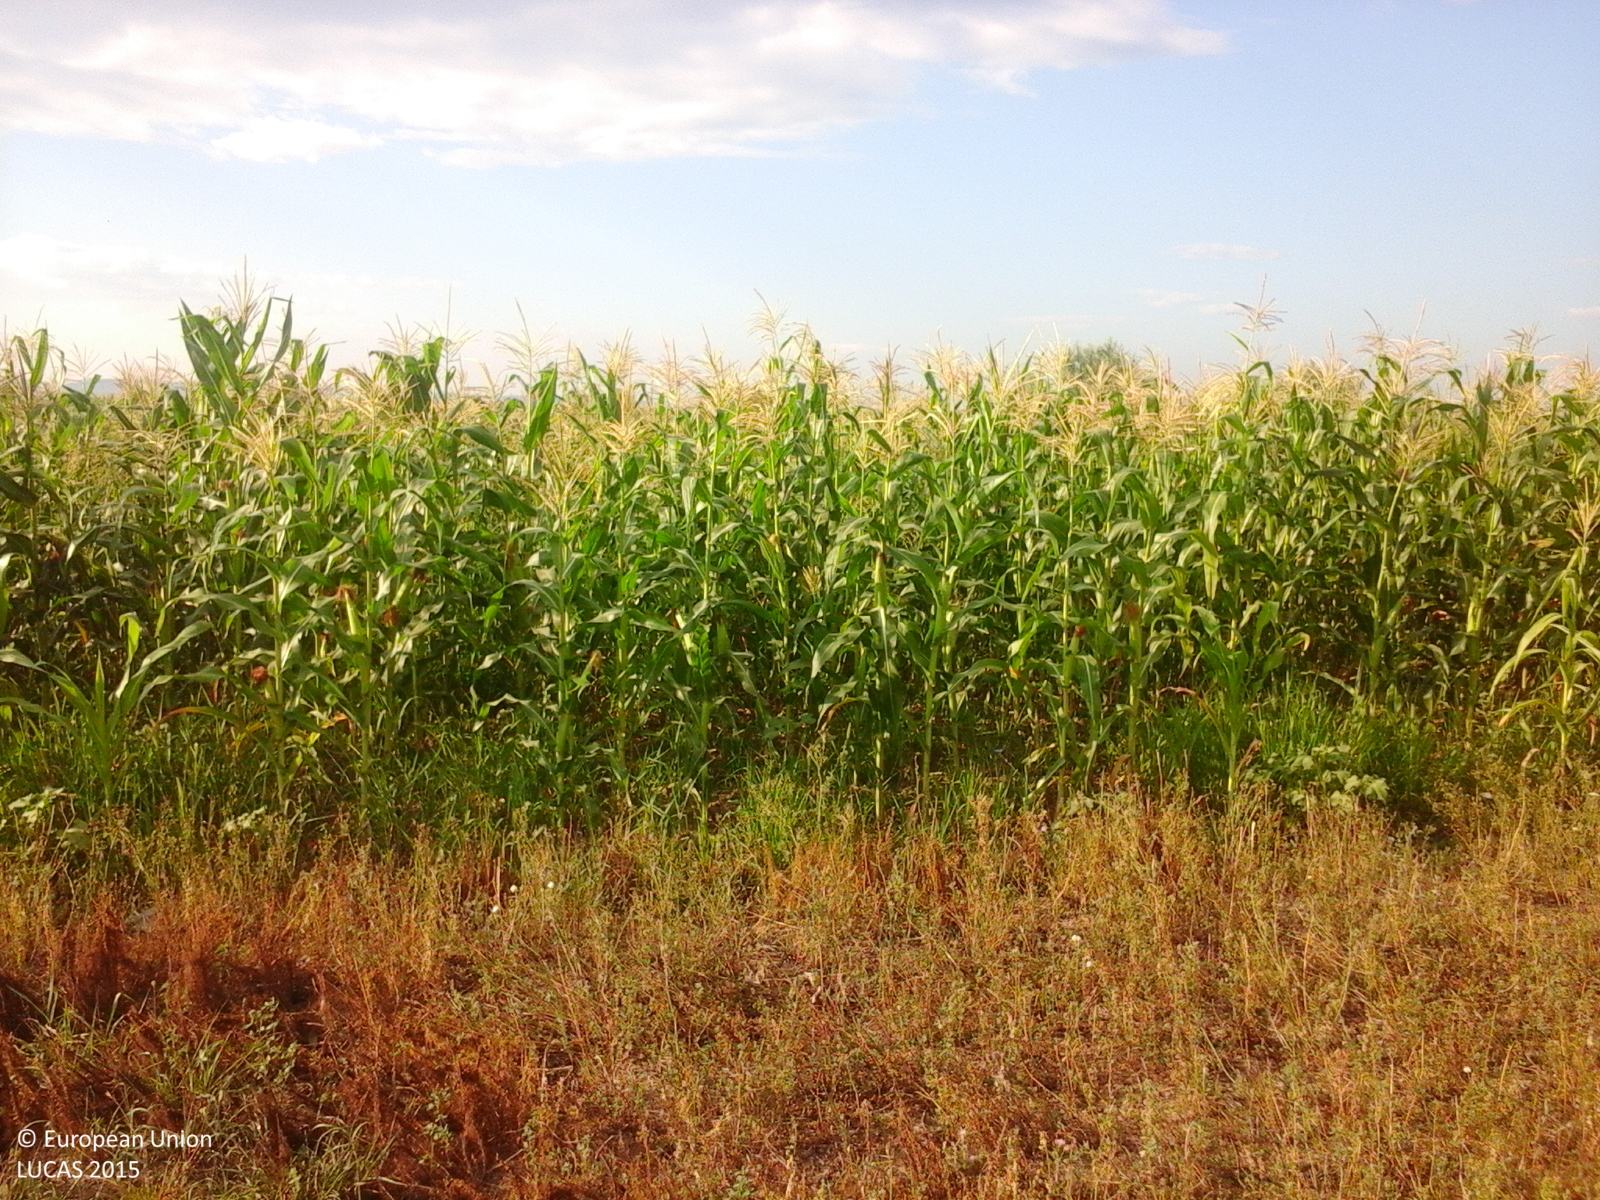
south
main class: Cropland
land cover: Lucerne
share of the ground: > 75 %
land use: Agriculture (excluding fallow land and kitchen gardens)
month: July
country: RO
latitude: 46.1147
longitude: 27.2444
